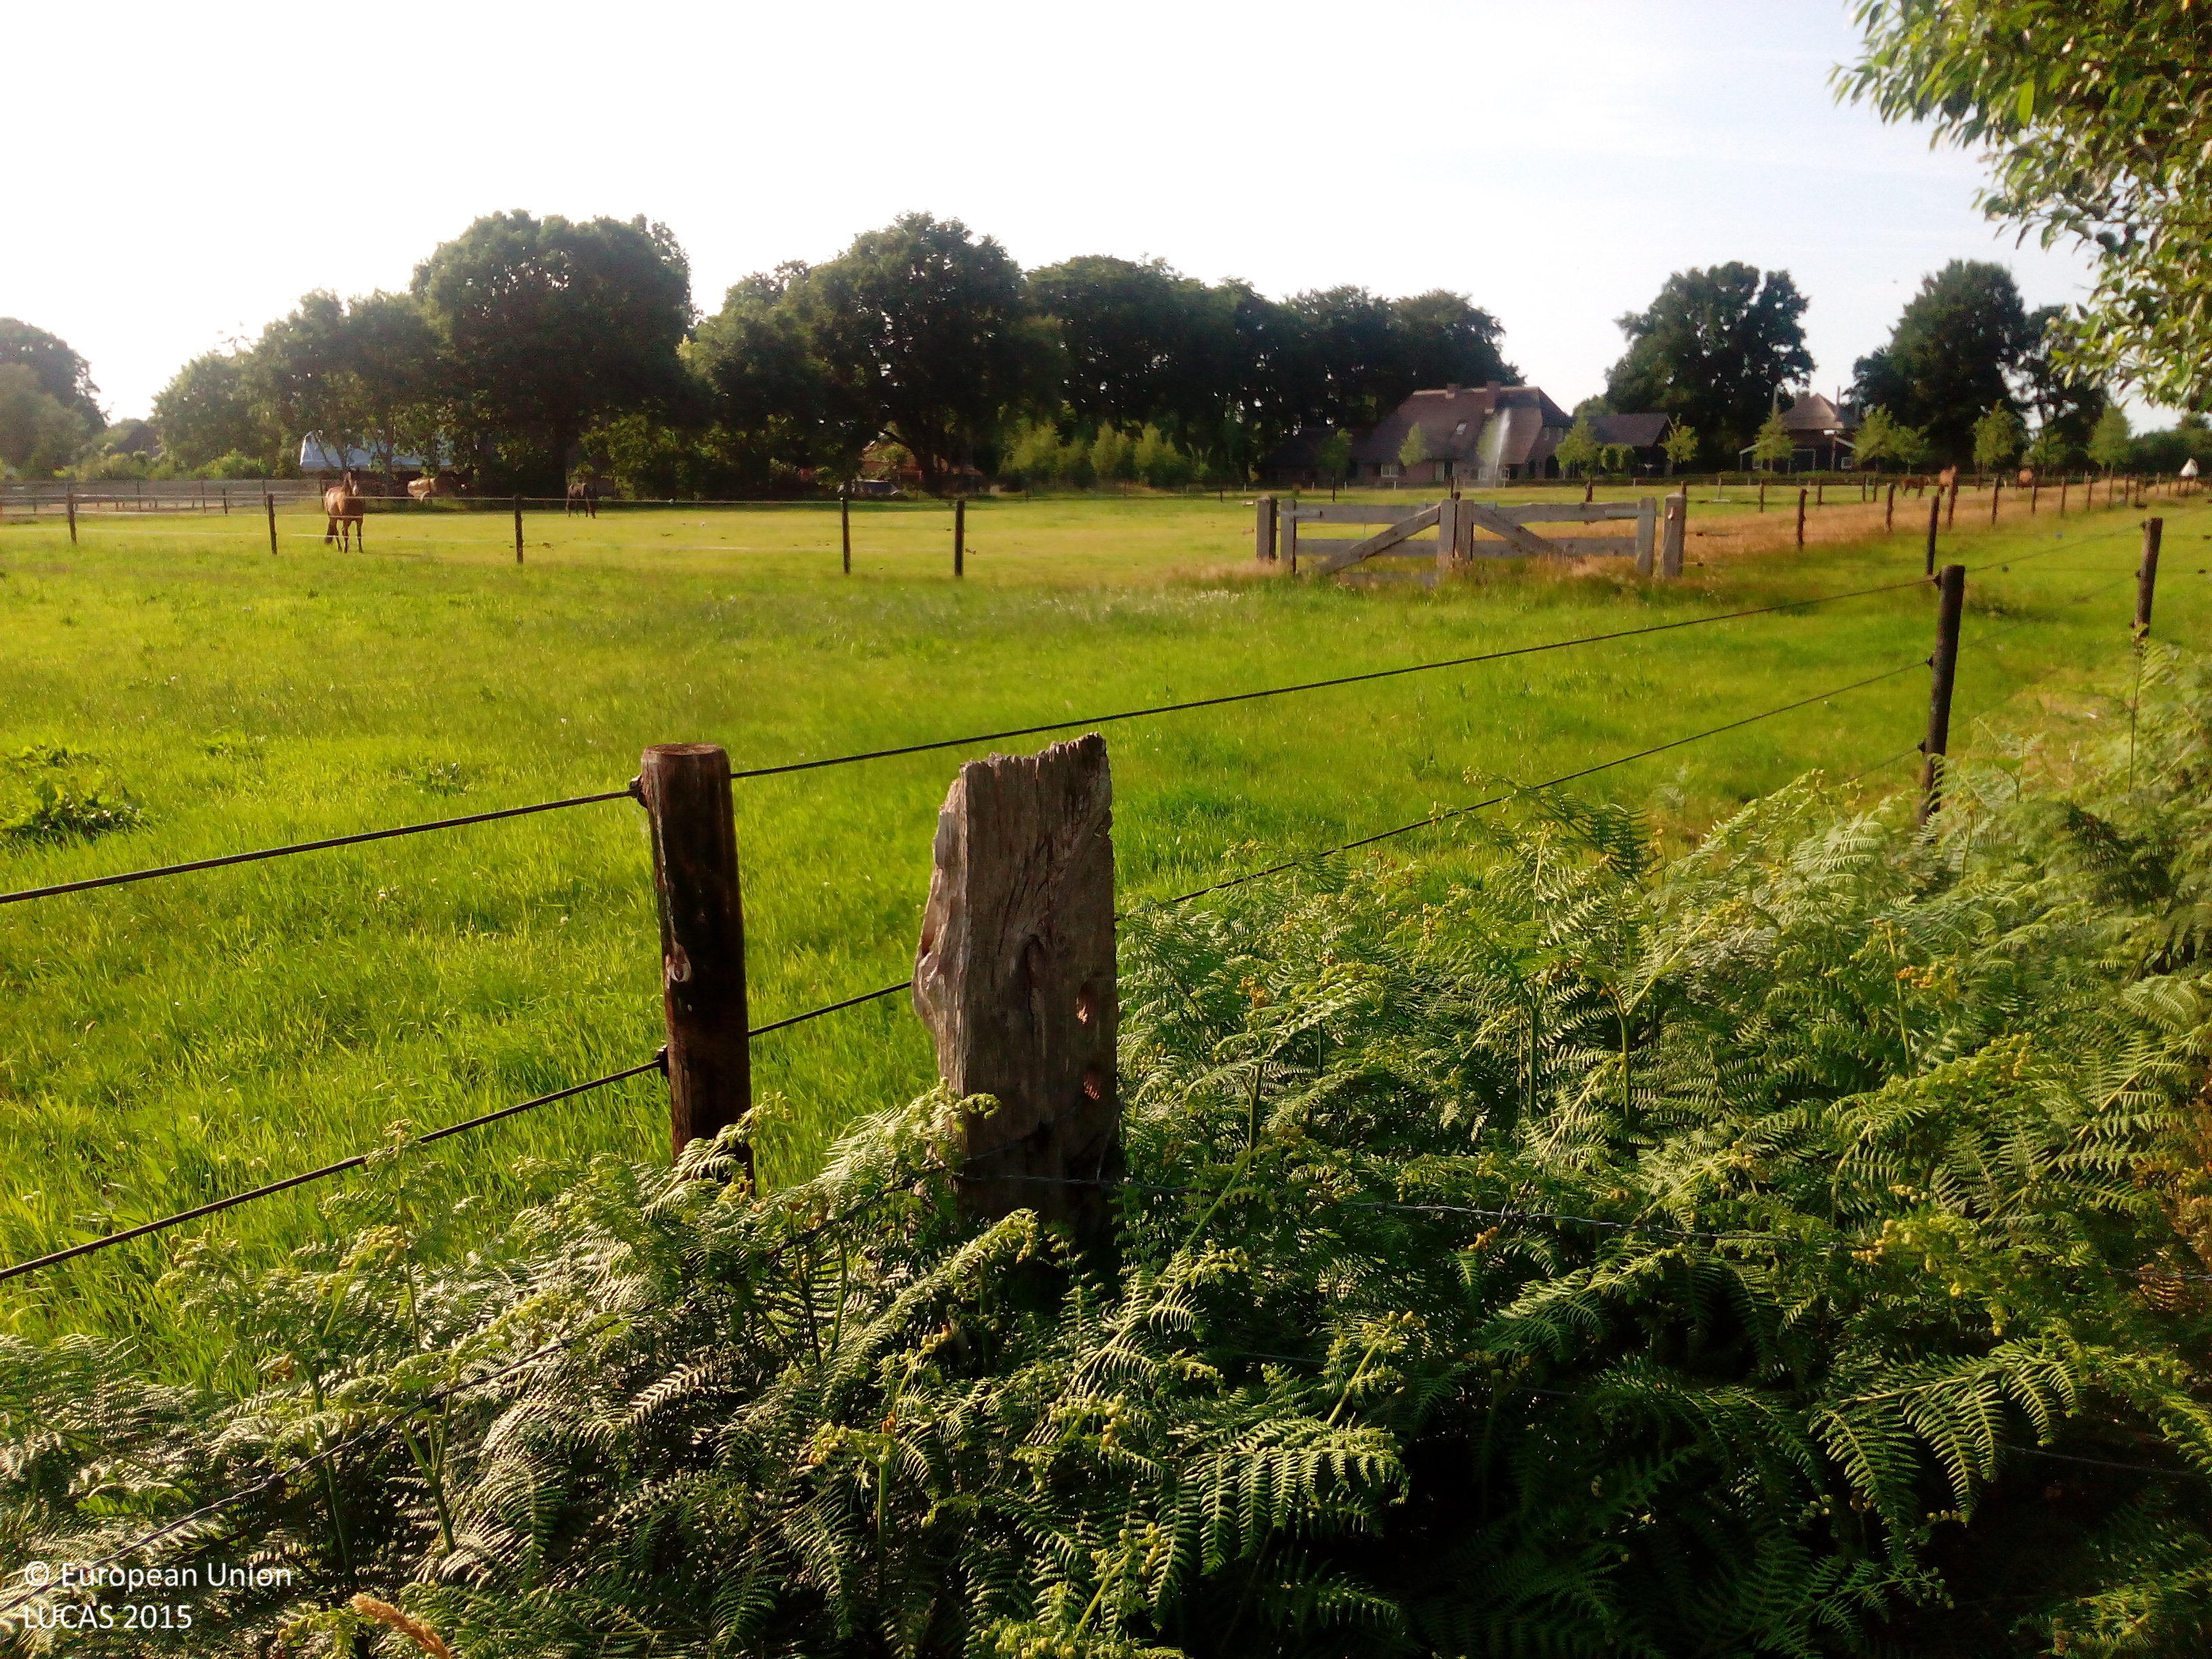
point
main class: Grassland
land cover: Grassland without tree/shrub cover
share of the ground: > 75 %
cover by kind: herbaceous plants 100 %
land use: Agriculture (excluding fallow land and kitchen gardens)
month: June
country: NL
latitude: 52.3525
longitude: 5.6676
